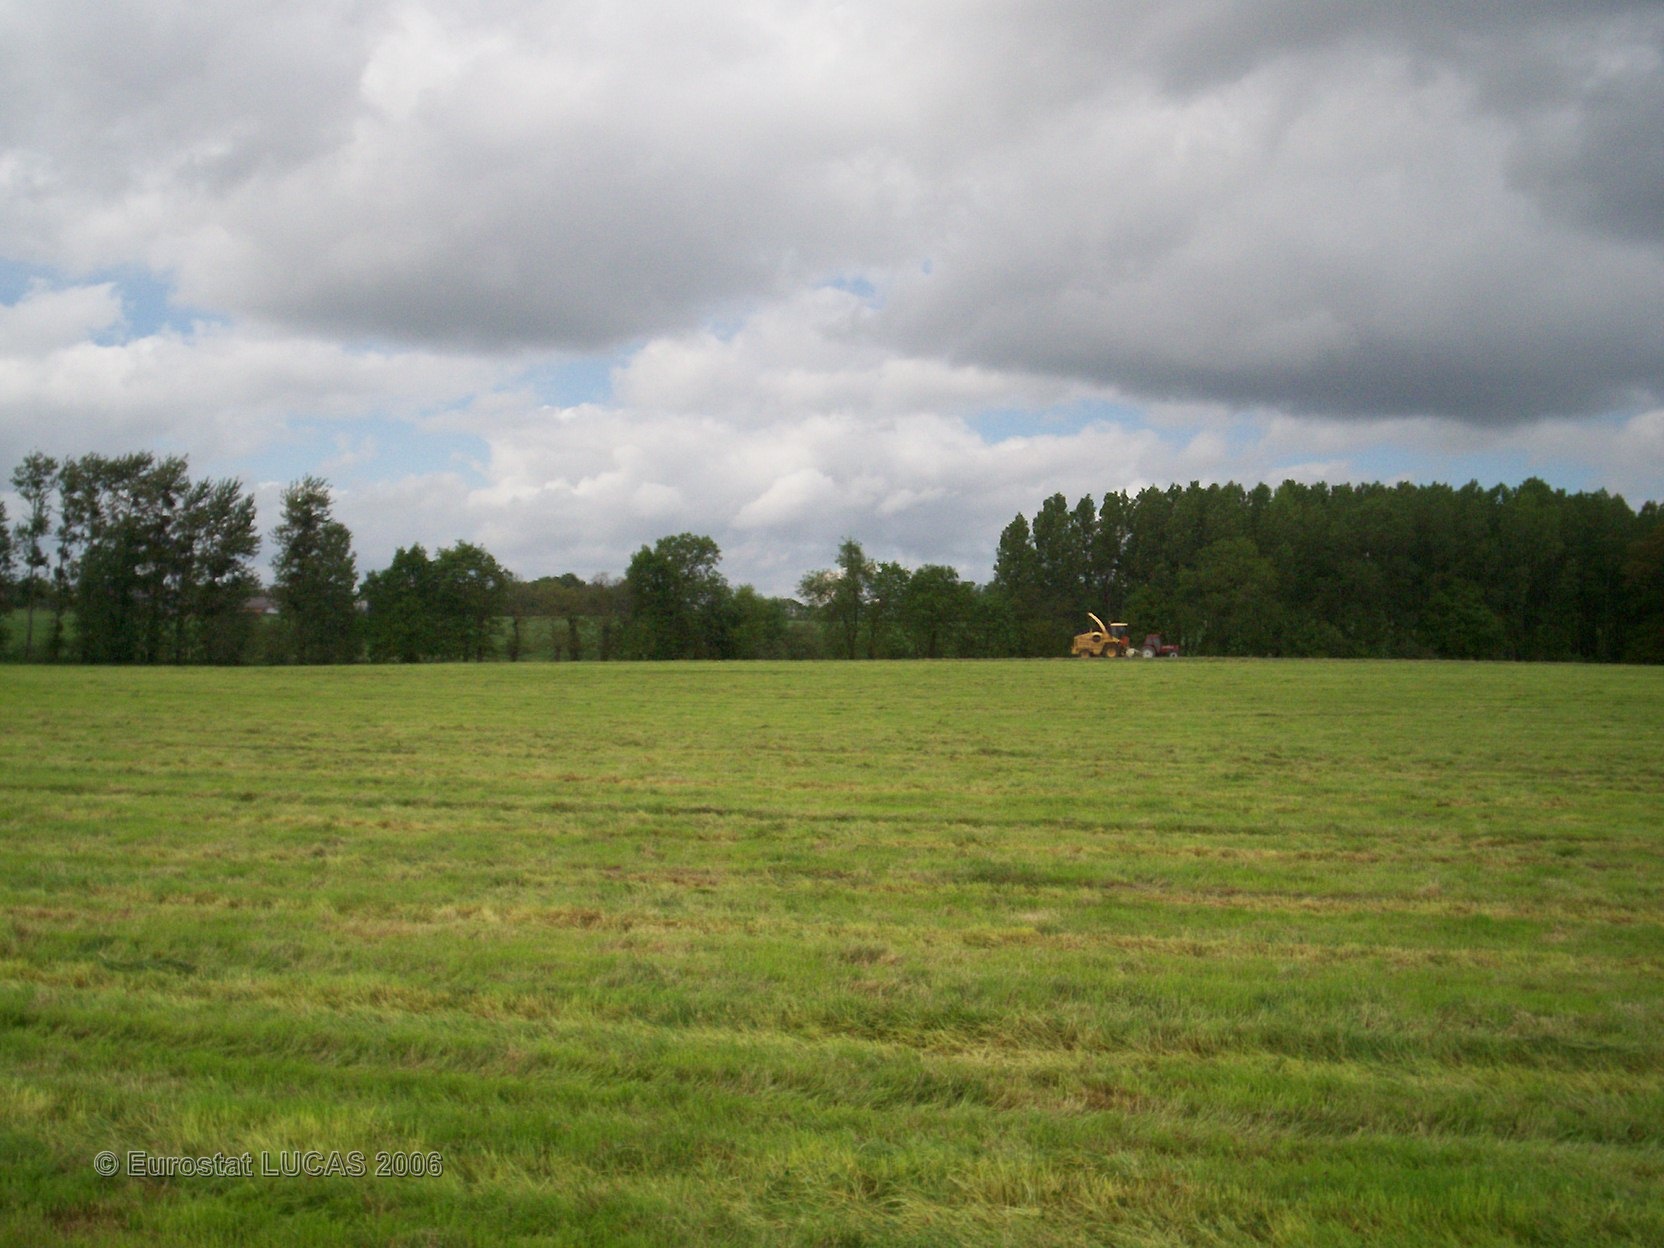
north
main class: Grassland
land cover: Grassland without tree/shrub cover
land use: Agriculture (excluding fallow land and kitchen gardens)
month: May
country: FR
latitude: 47.9434
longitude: -2.3607
